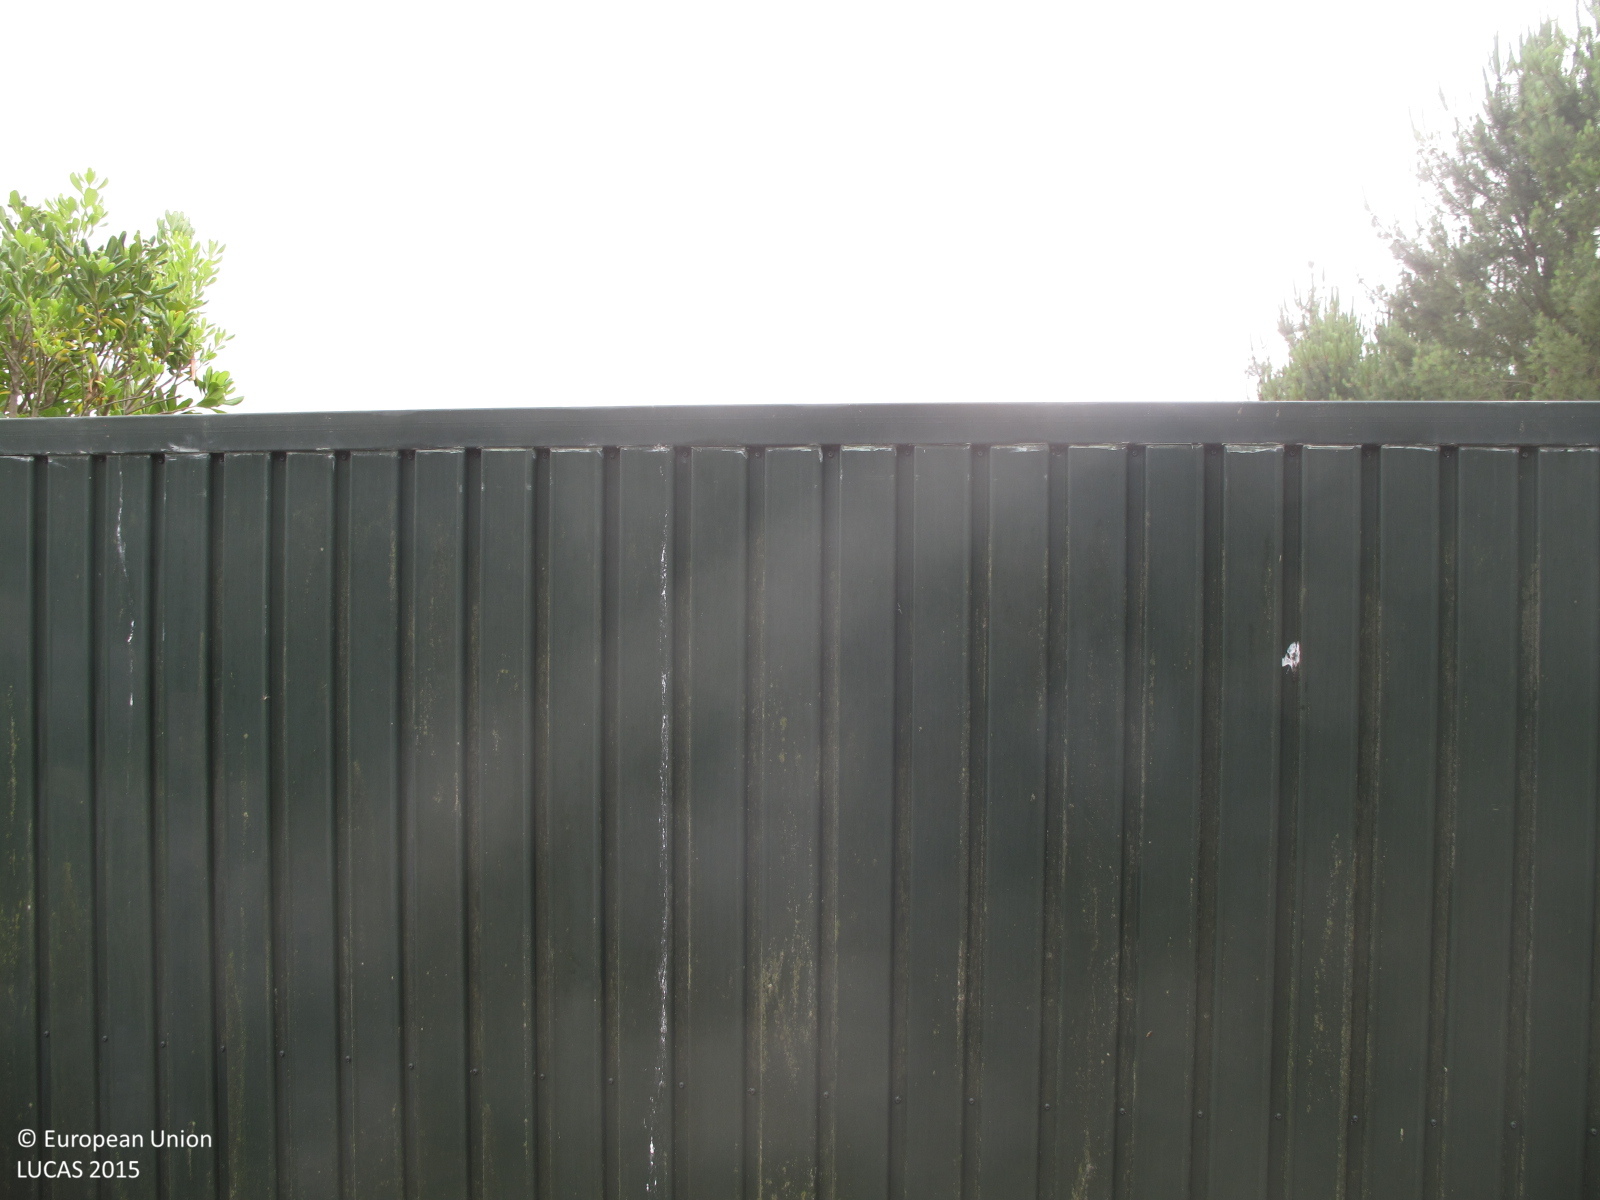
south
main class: Grassland
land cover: Grassland with sparse tree/shrub cover
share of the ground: > 75 %
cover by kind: herbaceous plants 95 %, broadleaved forest trees 5 %
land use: Residential
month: July
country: ES
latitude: 43.2996
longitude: -8.2842
